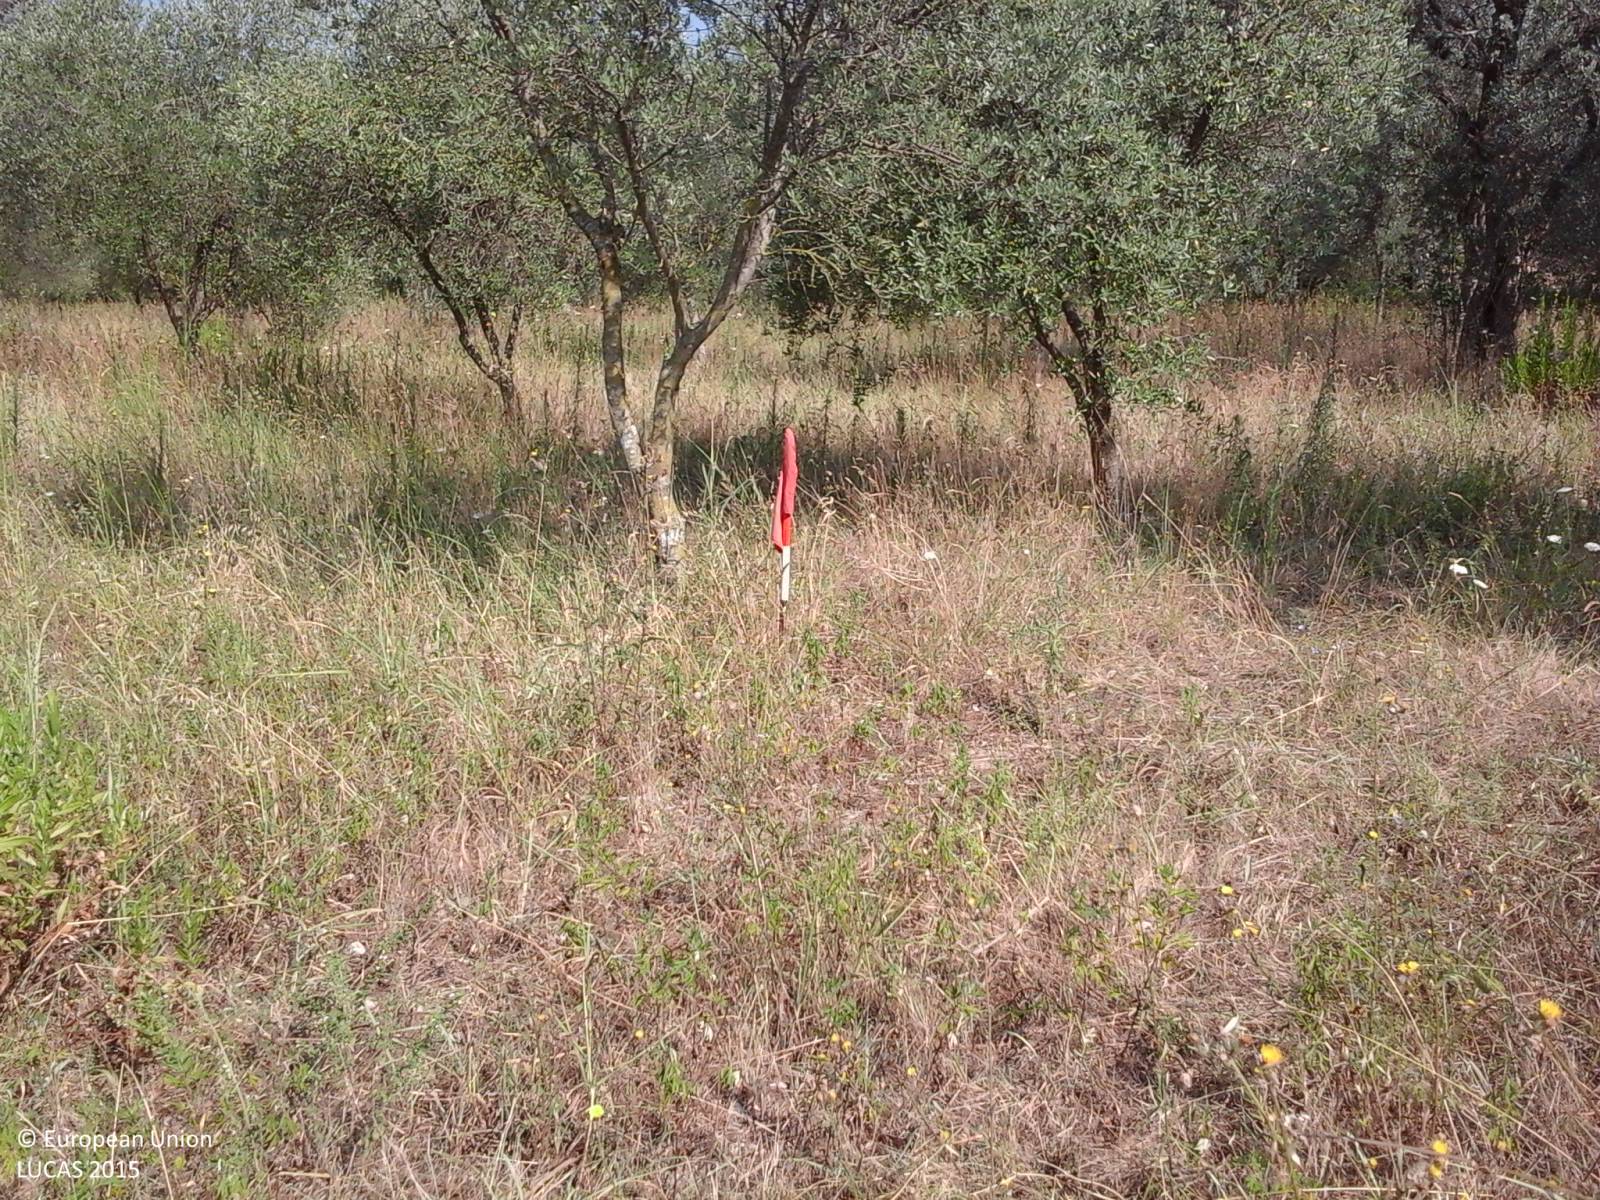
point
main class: Cropland
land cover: Olive groves
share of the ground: 50 - 75 %
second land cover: Spontaneously vegetated surfaces
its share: > 75 %
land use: Agriculture (excluding fallow land and kitchen gardens)
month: August
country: IT
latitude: 41.3495
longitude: 14.3223
